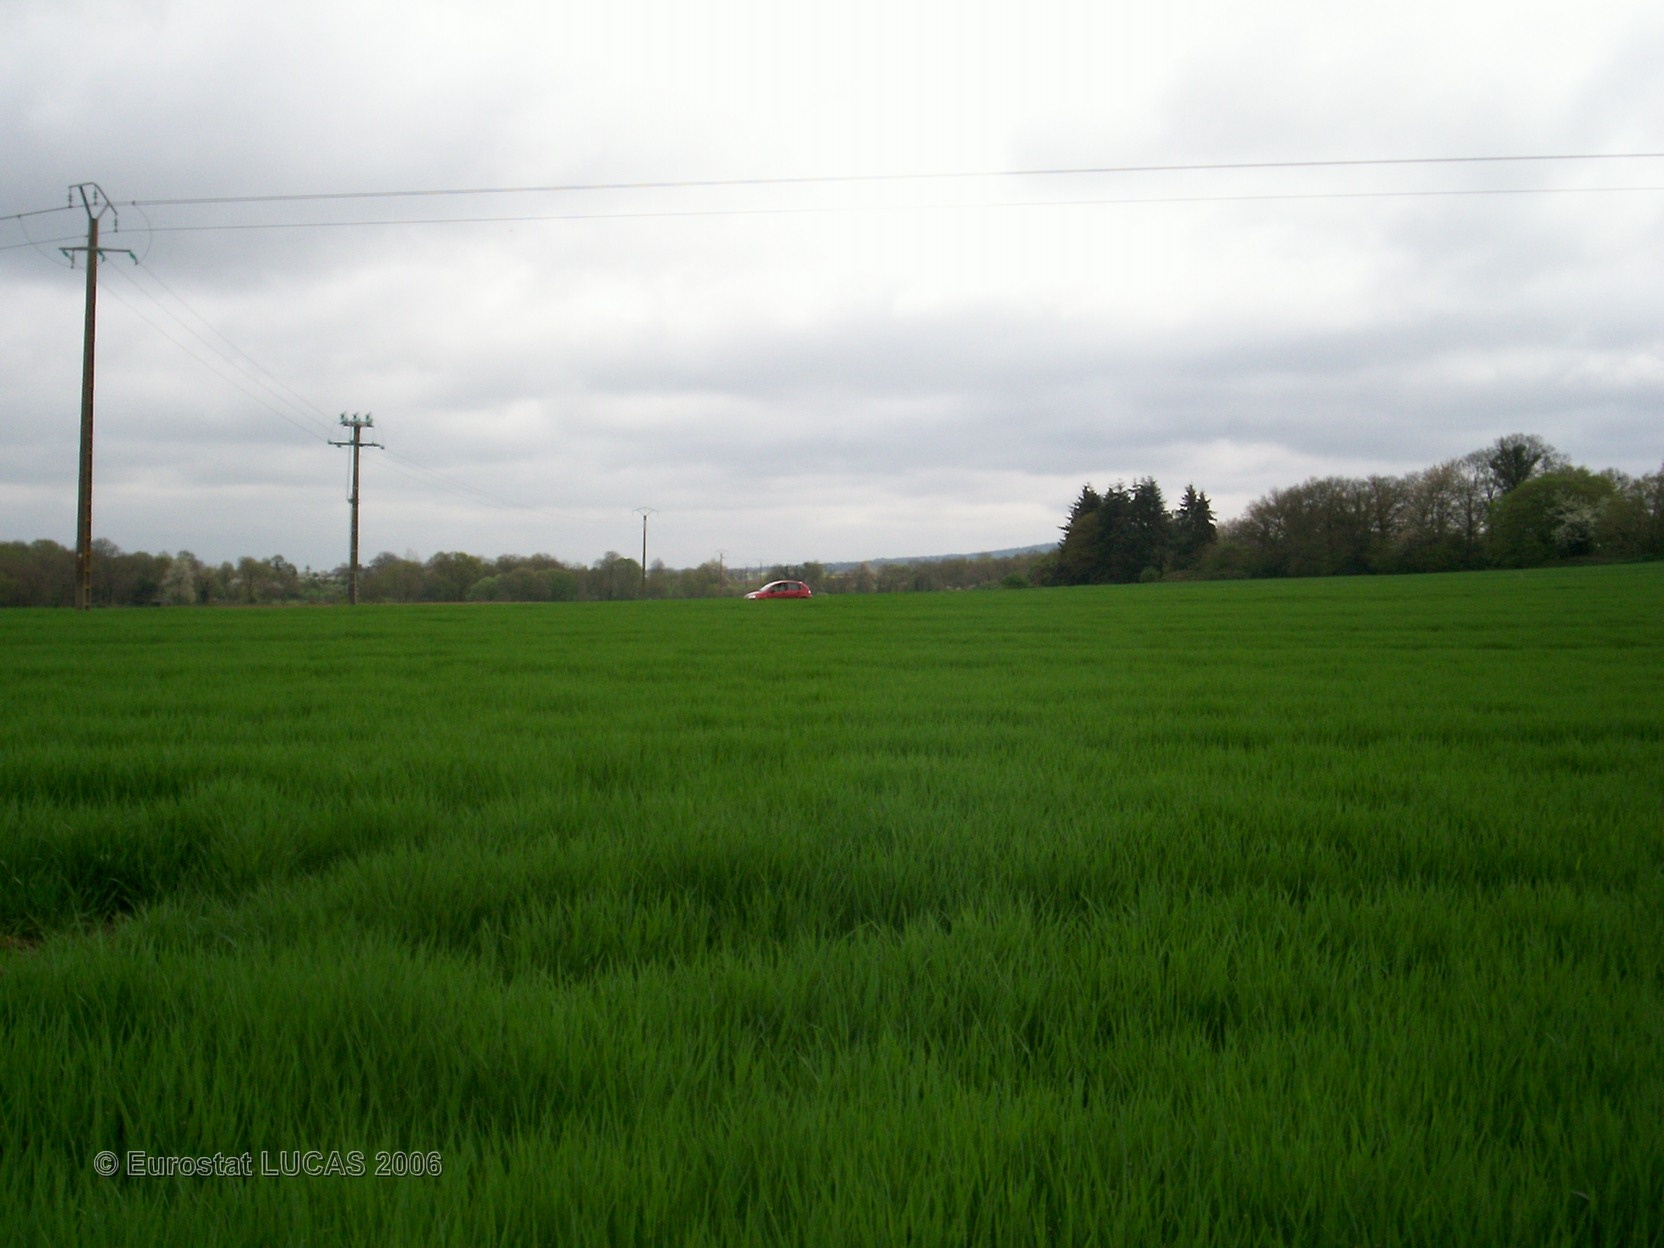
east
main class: Cropland
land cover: Barley
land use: Agriculture (excluding fallow land and kitchen gardens)
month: April
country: FR
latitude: 48.0409
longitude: -2.3029
